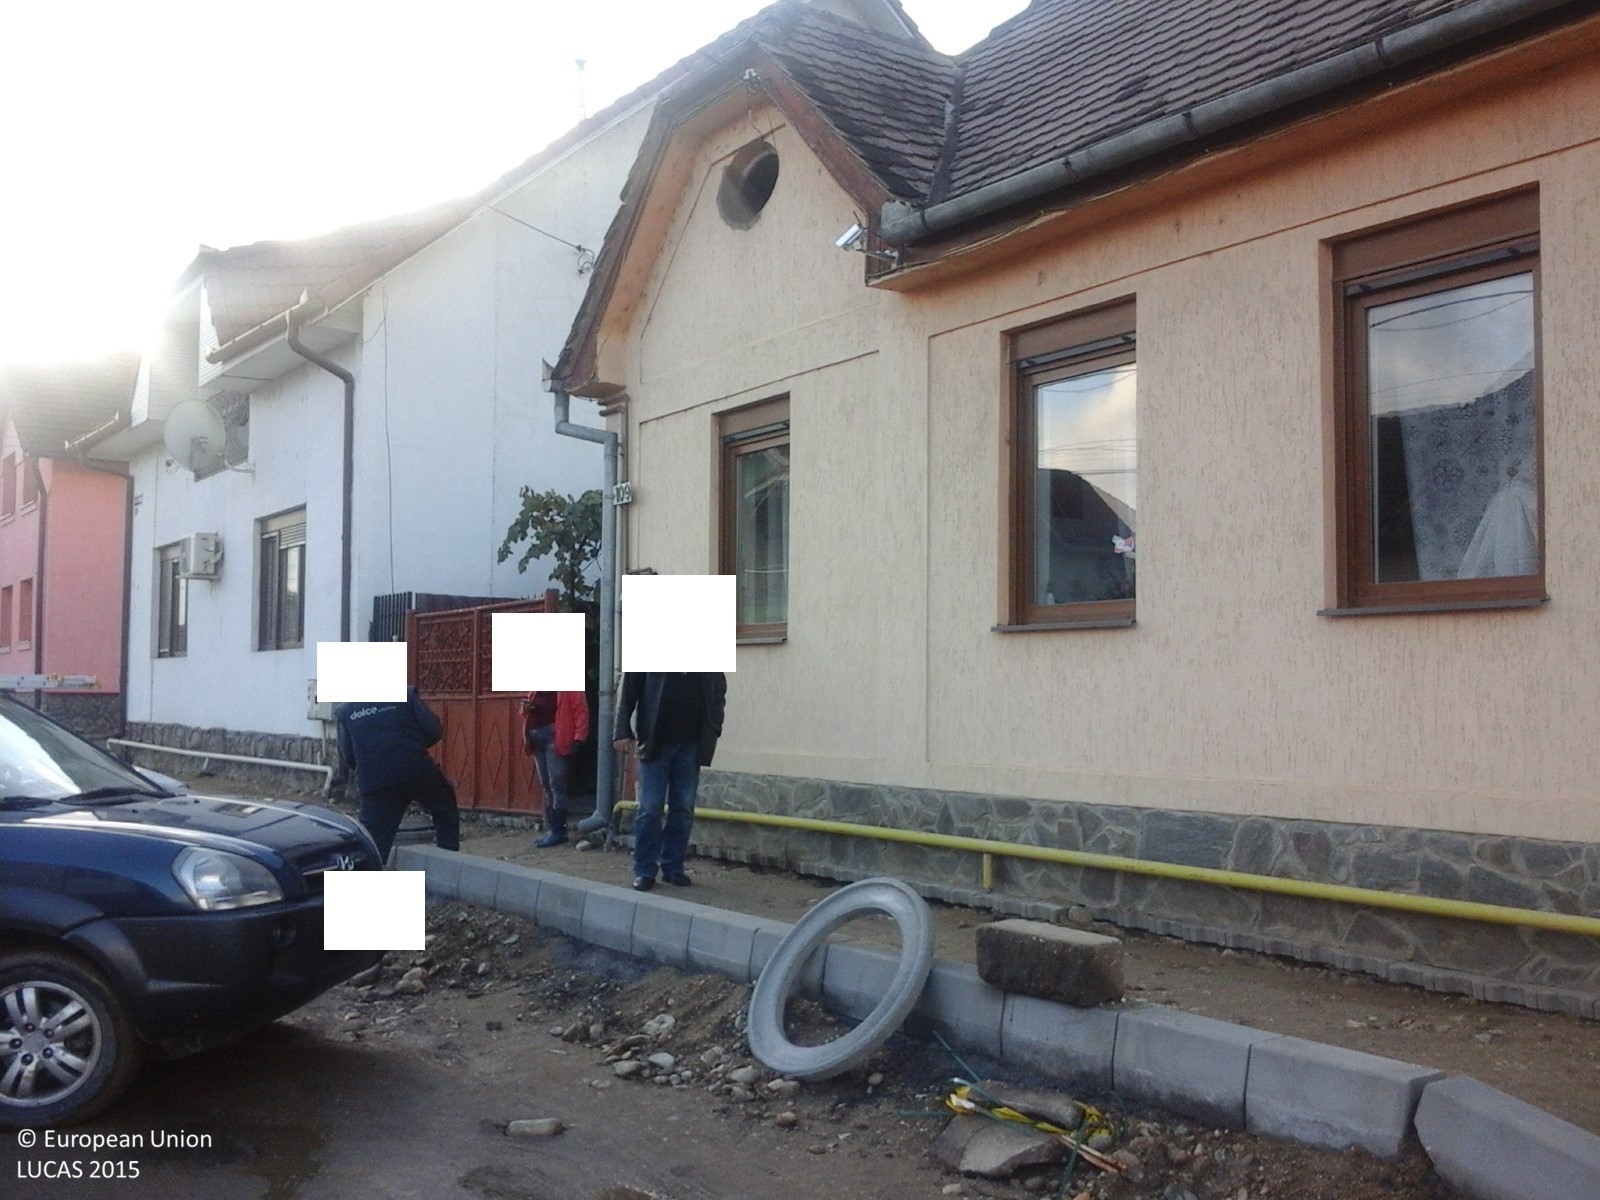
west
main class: Cropland
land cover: Vineyards
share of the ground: > 75 %
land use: Agriculture (excluding fallow land and kitchen gardens)
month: October
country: RO
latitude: 45.8082
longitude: 24.1395
